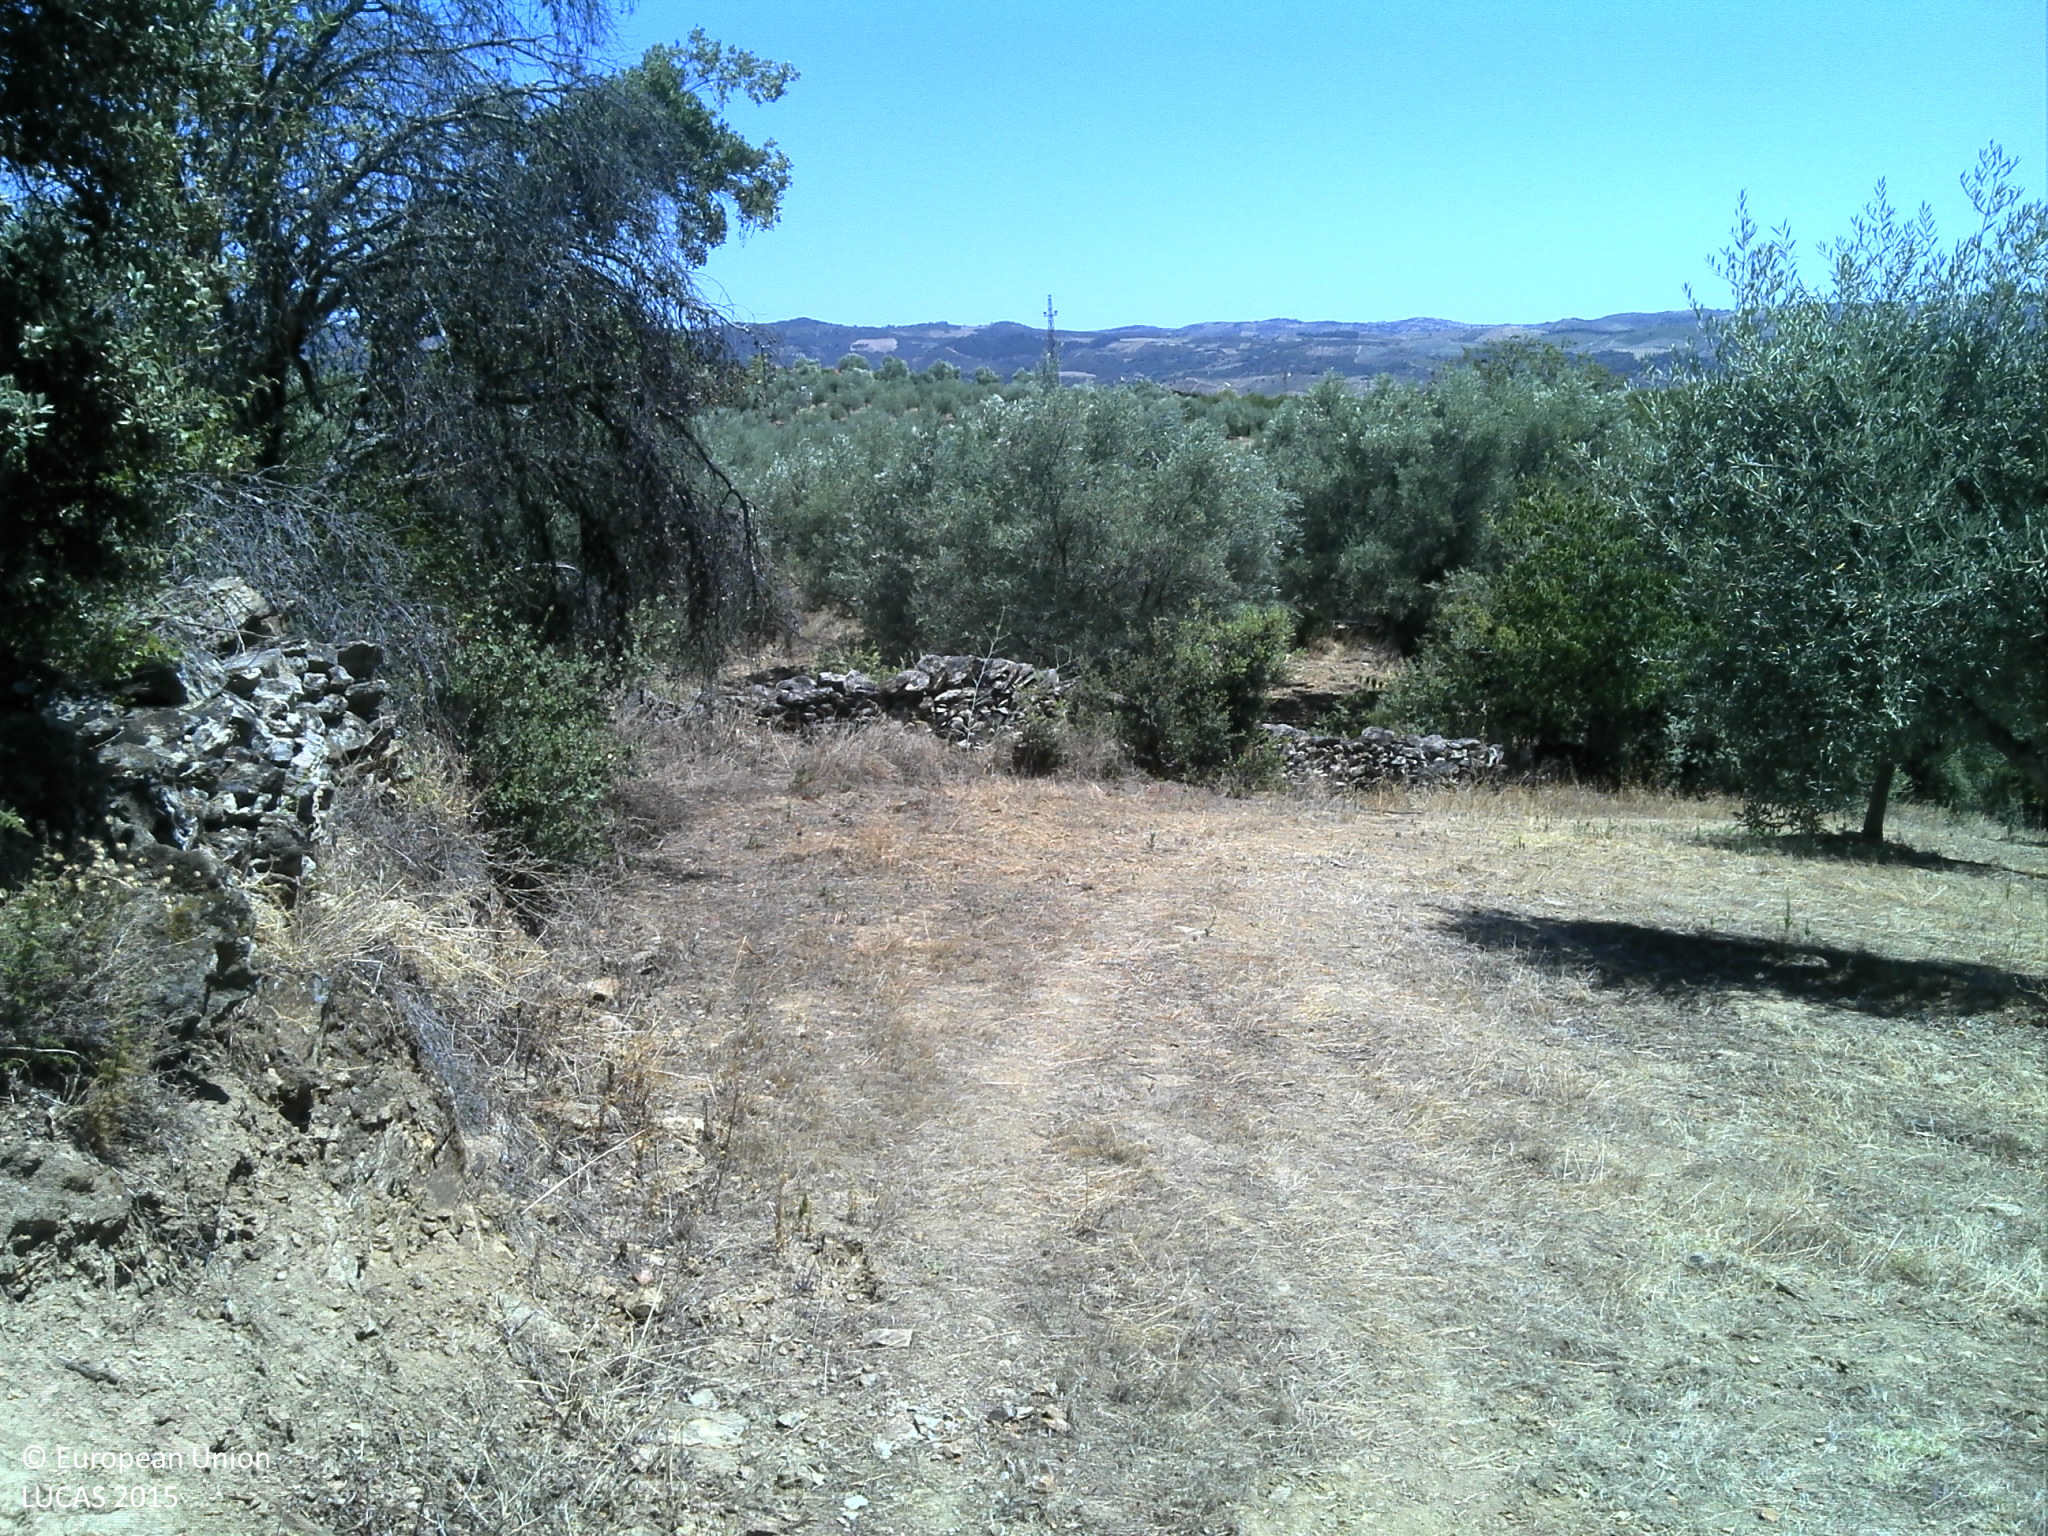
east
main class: Cropland
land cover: Olive groves
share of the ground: 10 - 25 %
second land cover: Spontaneously vegetated surfaces
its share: 25 - 50 %
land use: Agriculture (excluding fallow land and kitchen gardens)
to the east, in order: Olive groves; Spontaneously vegetated surfaces; Olive groves; Dry stone walls; Olive groves; Dry stone walls; Olive groves; Tracks; Olive groves; Electric lines; Olive groves; Tracks; Nuts trees
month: July
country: PT
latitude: 41.3571
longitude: -7.0759
